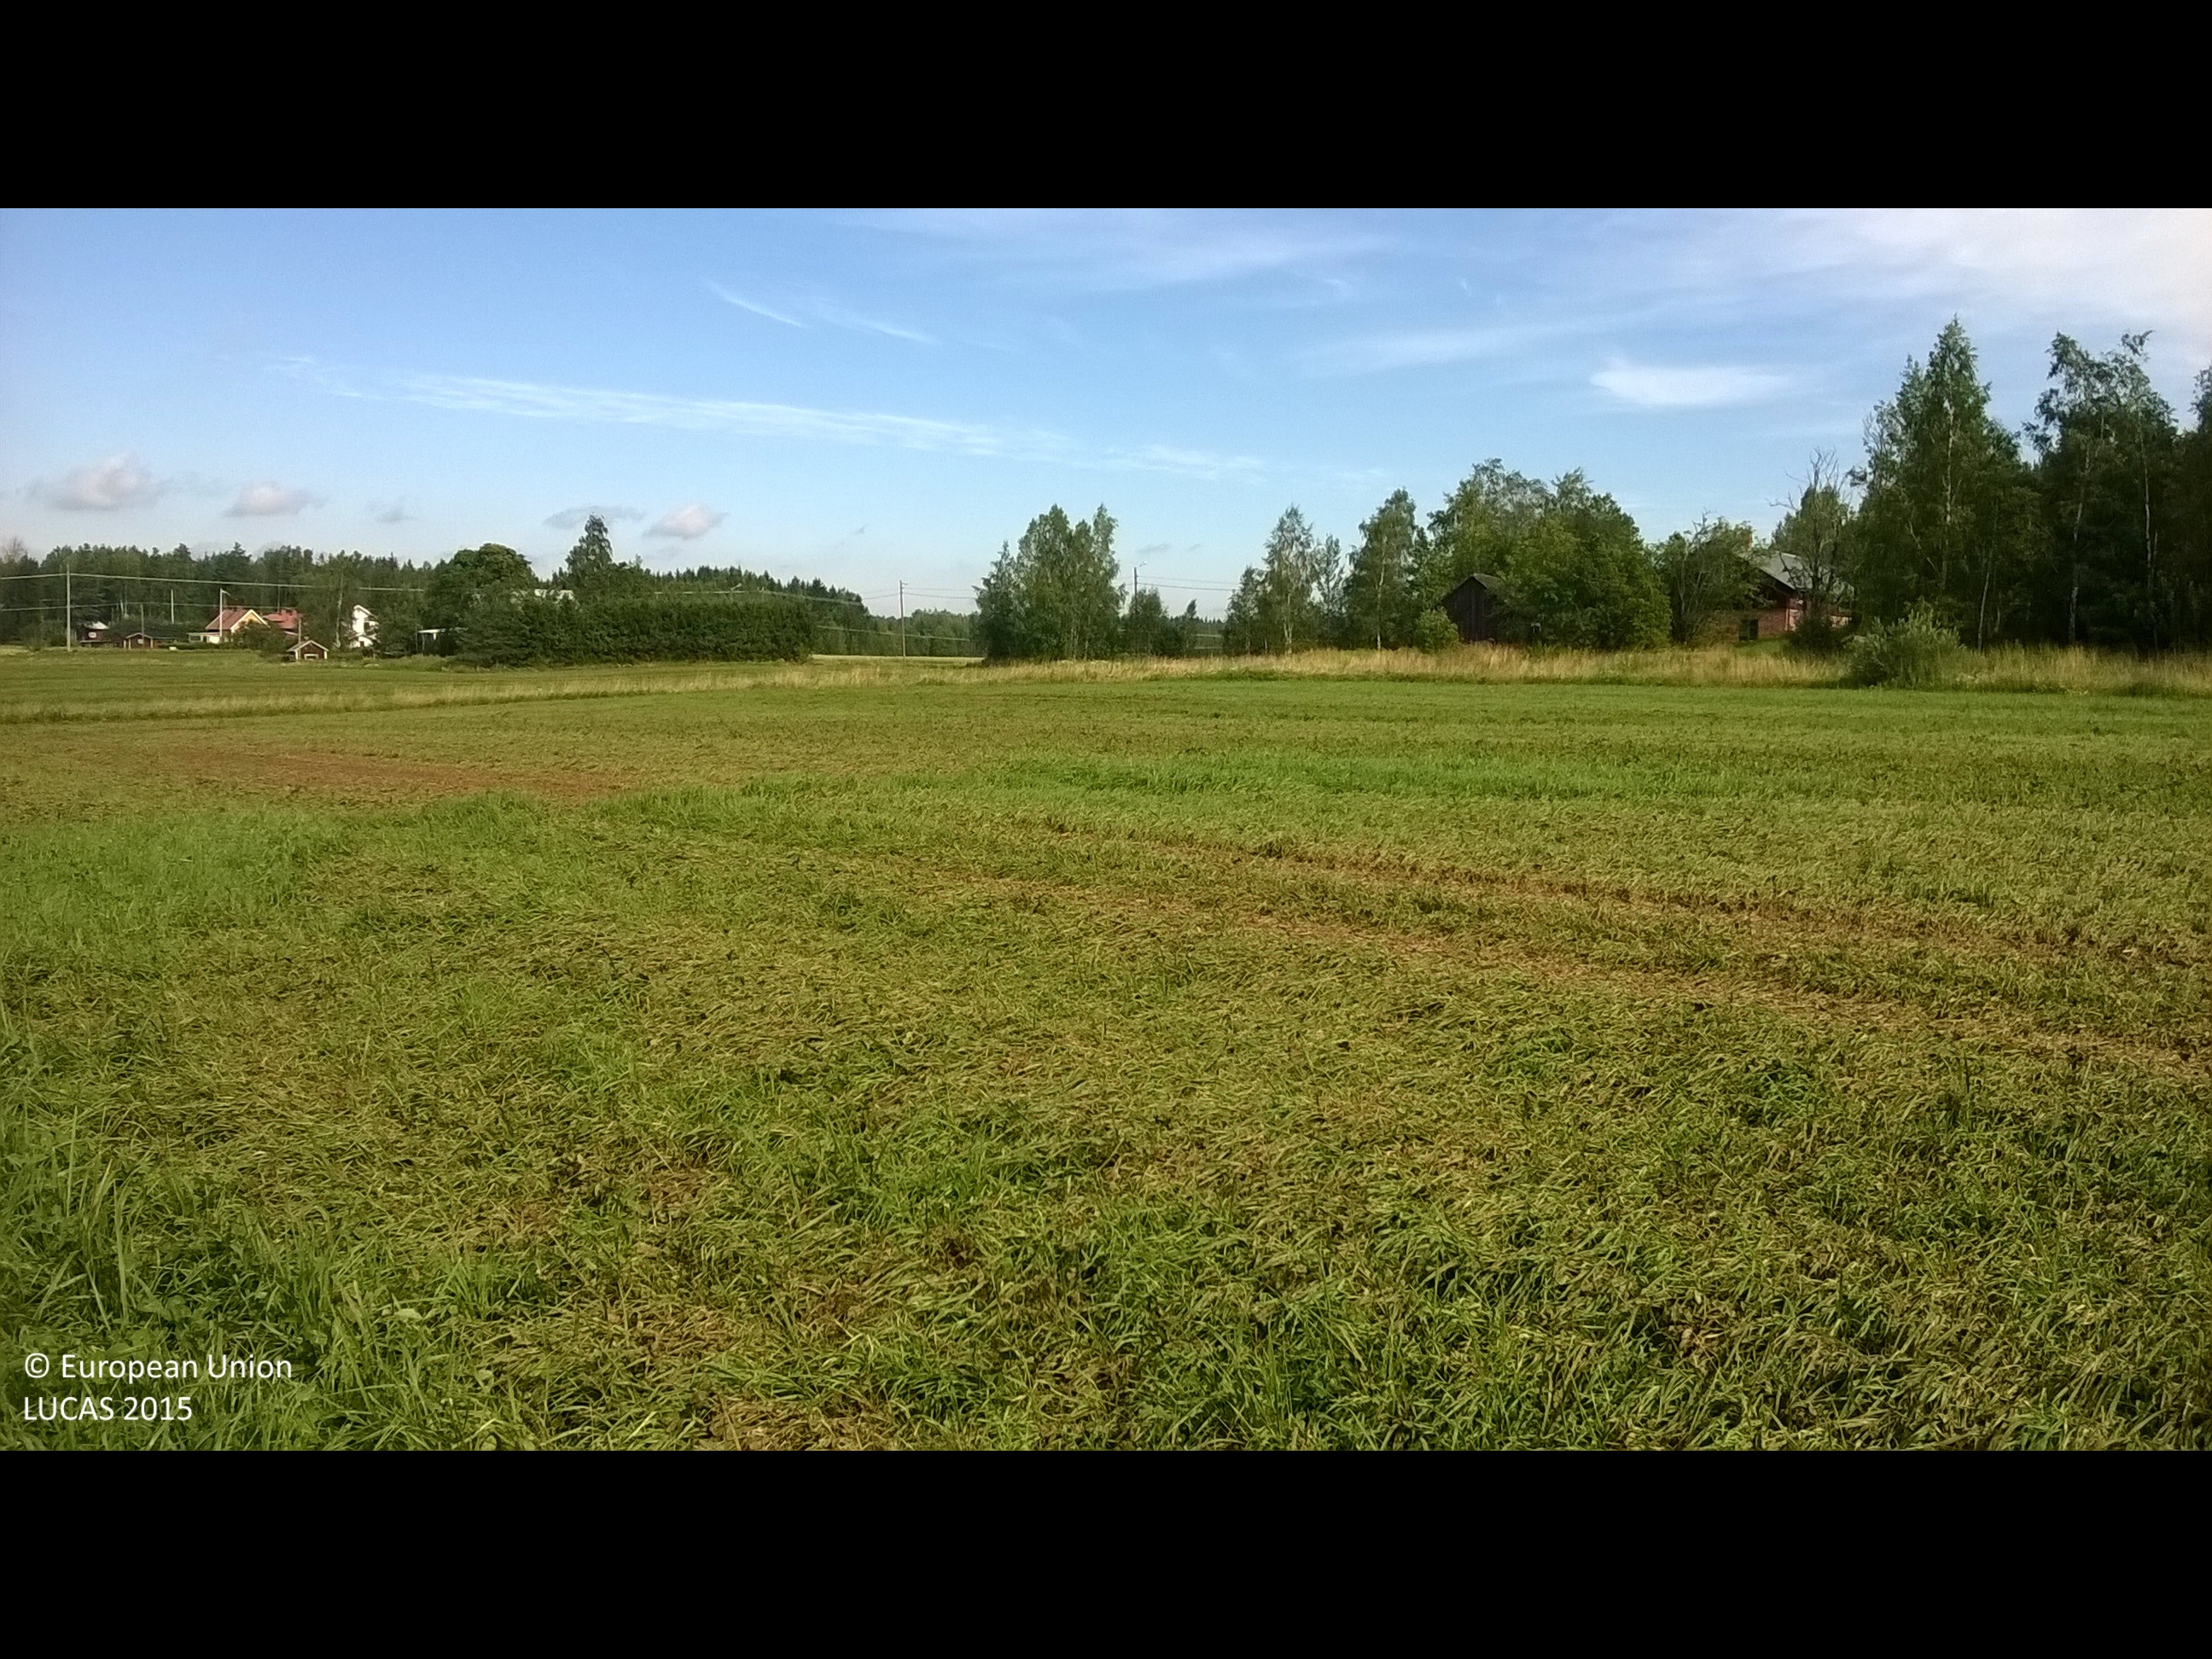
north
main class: Cropland
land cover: Common wheat
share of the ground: > 75 %
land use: Agriculture (excluding fallow land and kitchen gardens)
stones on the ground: < 10 %
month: August
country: SE
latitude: 60.6054
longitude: 16.5818
